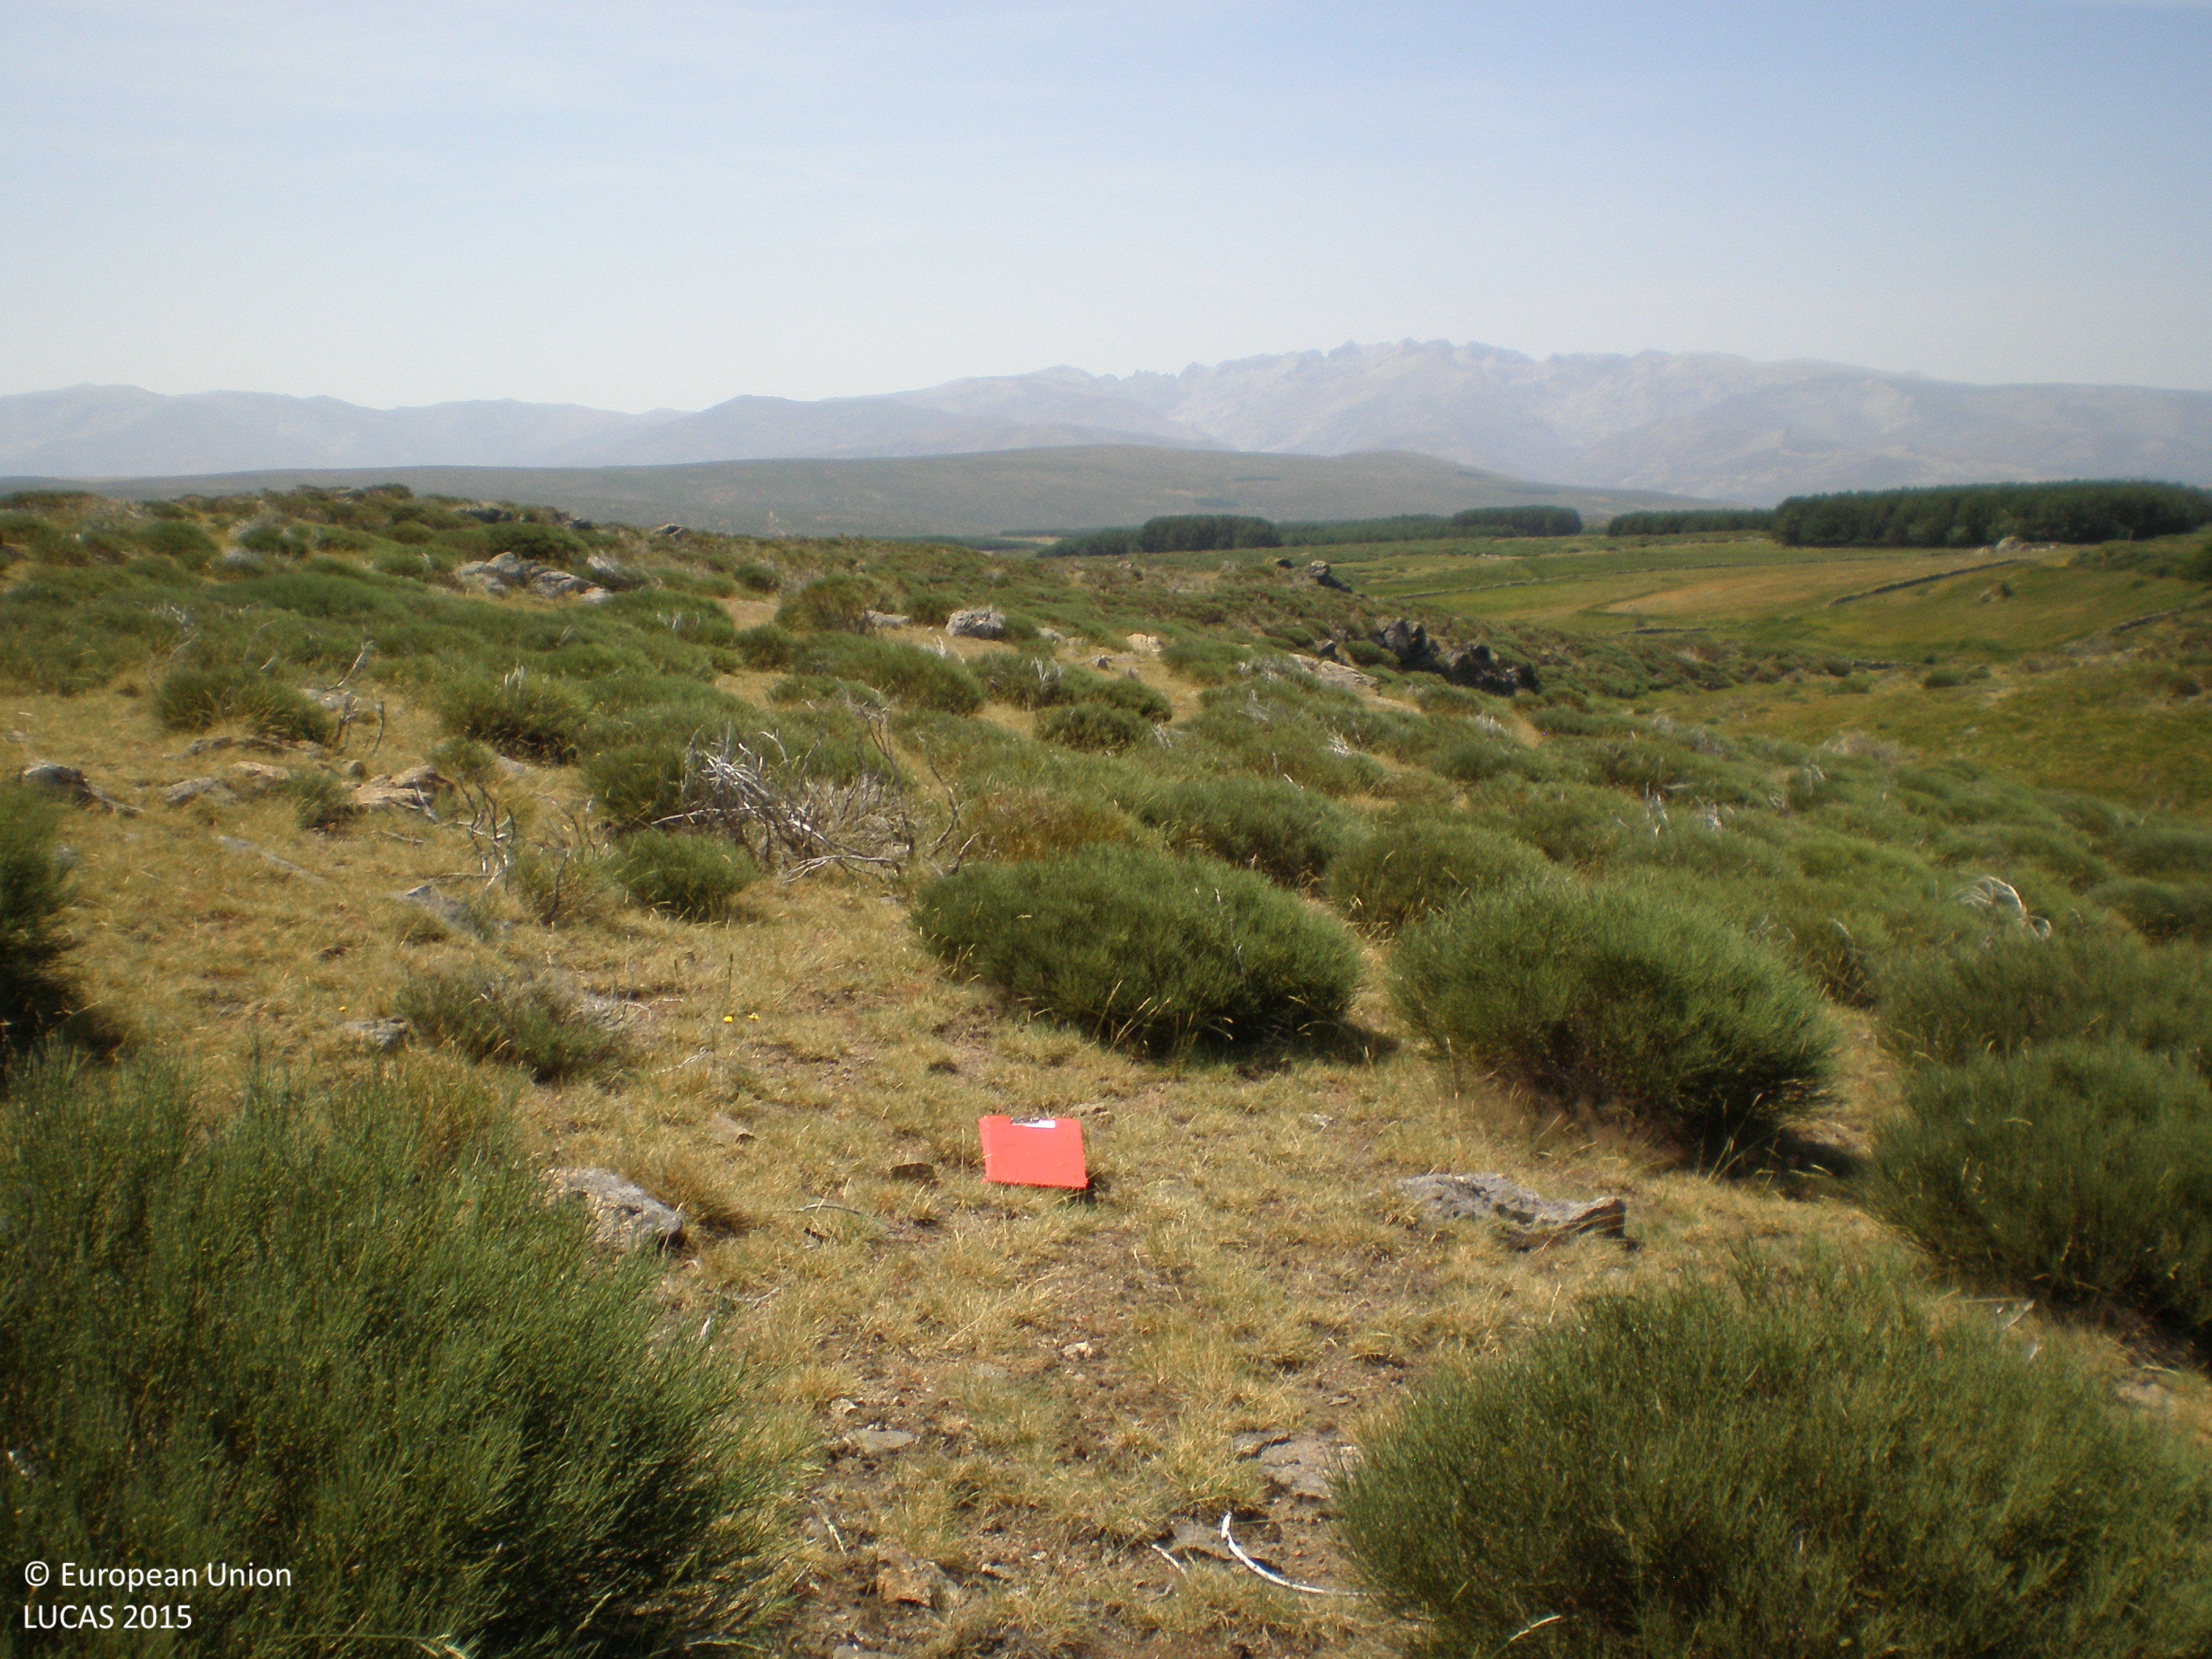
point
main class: Shrubland
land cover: Shrubland without tree cover
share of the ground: > 75 %
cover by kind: shrubs 80 %, herbaceous plants 20 %
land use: Agriculture (excluding fallow land and kitchen gardens)
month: July
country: ES
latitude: 40.4296
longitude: -5.2319
